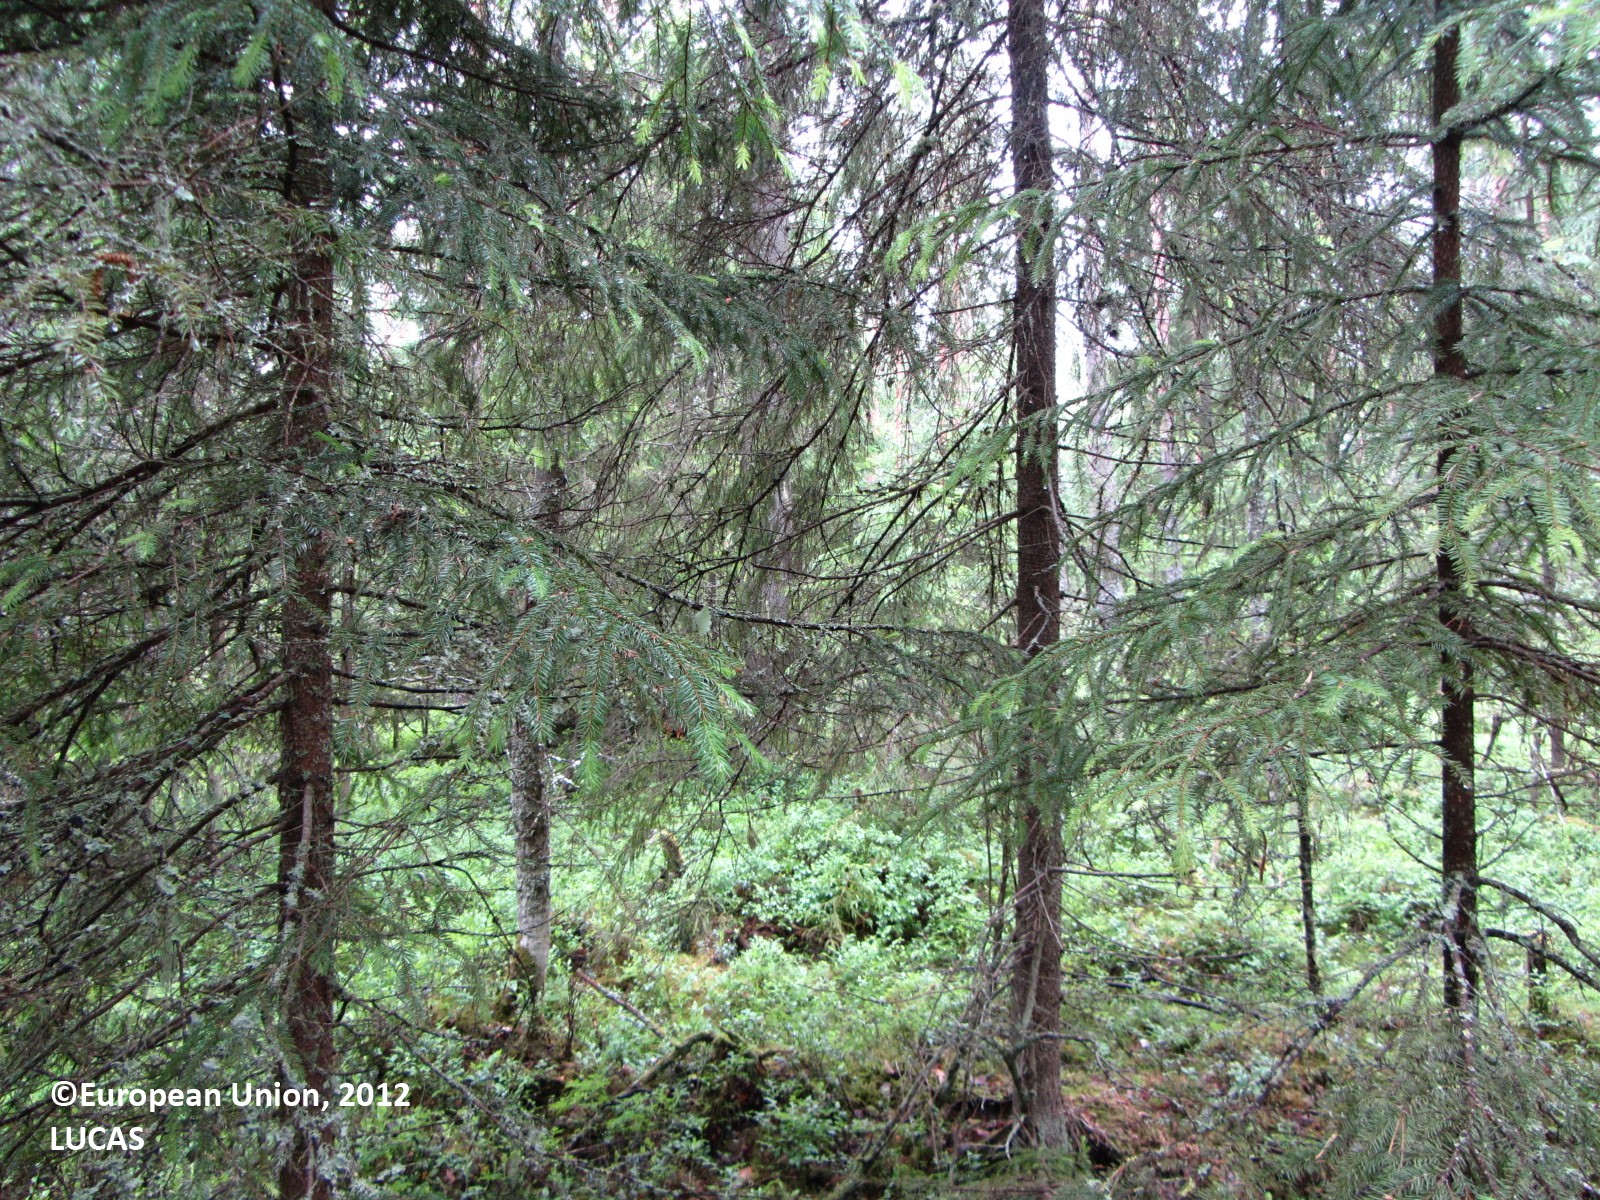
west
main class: Woodland
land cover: Other coniferous woodland
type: boreal forest
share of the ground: > 75 %
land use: Amenities, museums, leisure
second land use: Forestry
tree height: > 5 m
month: June
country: FI
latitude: 62.0160
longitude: 25.2209
